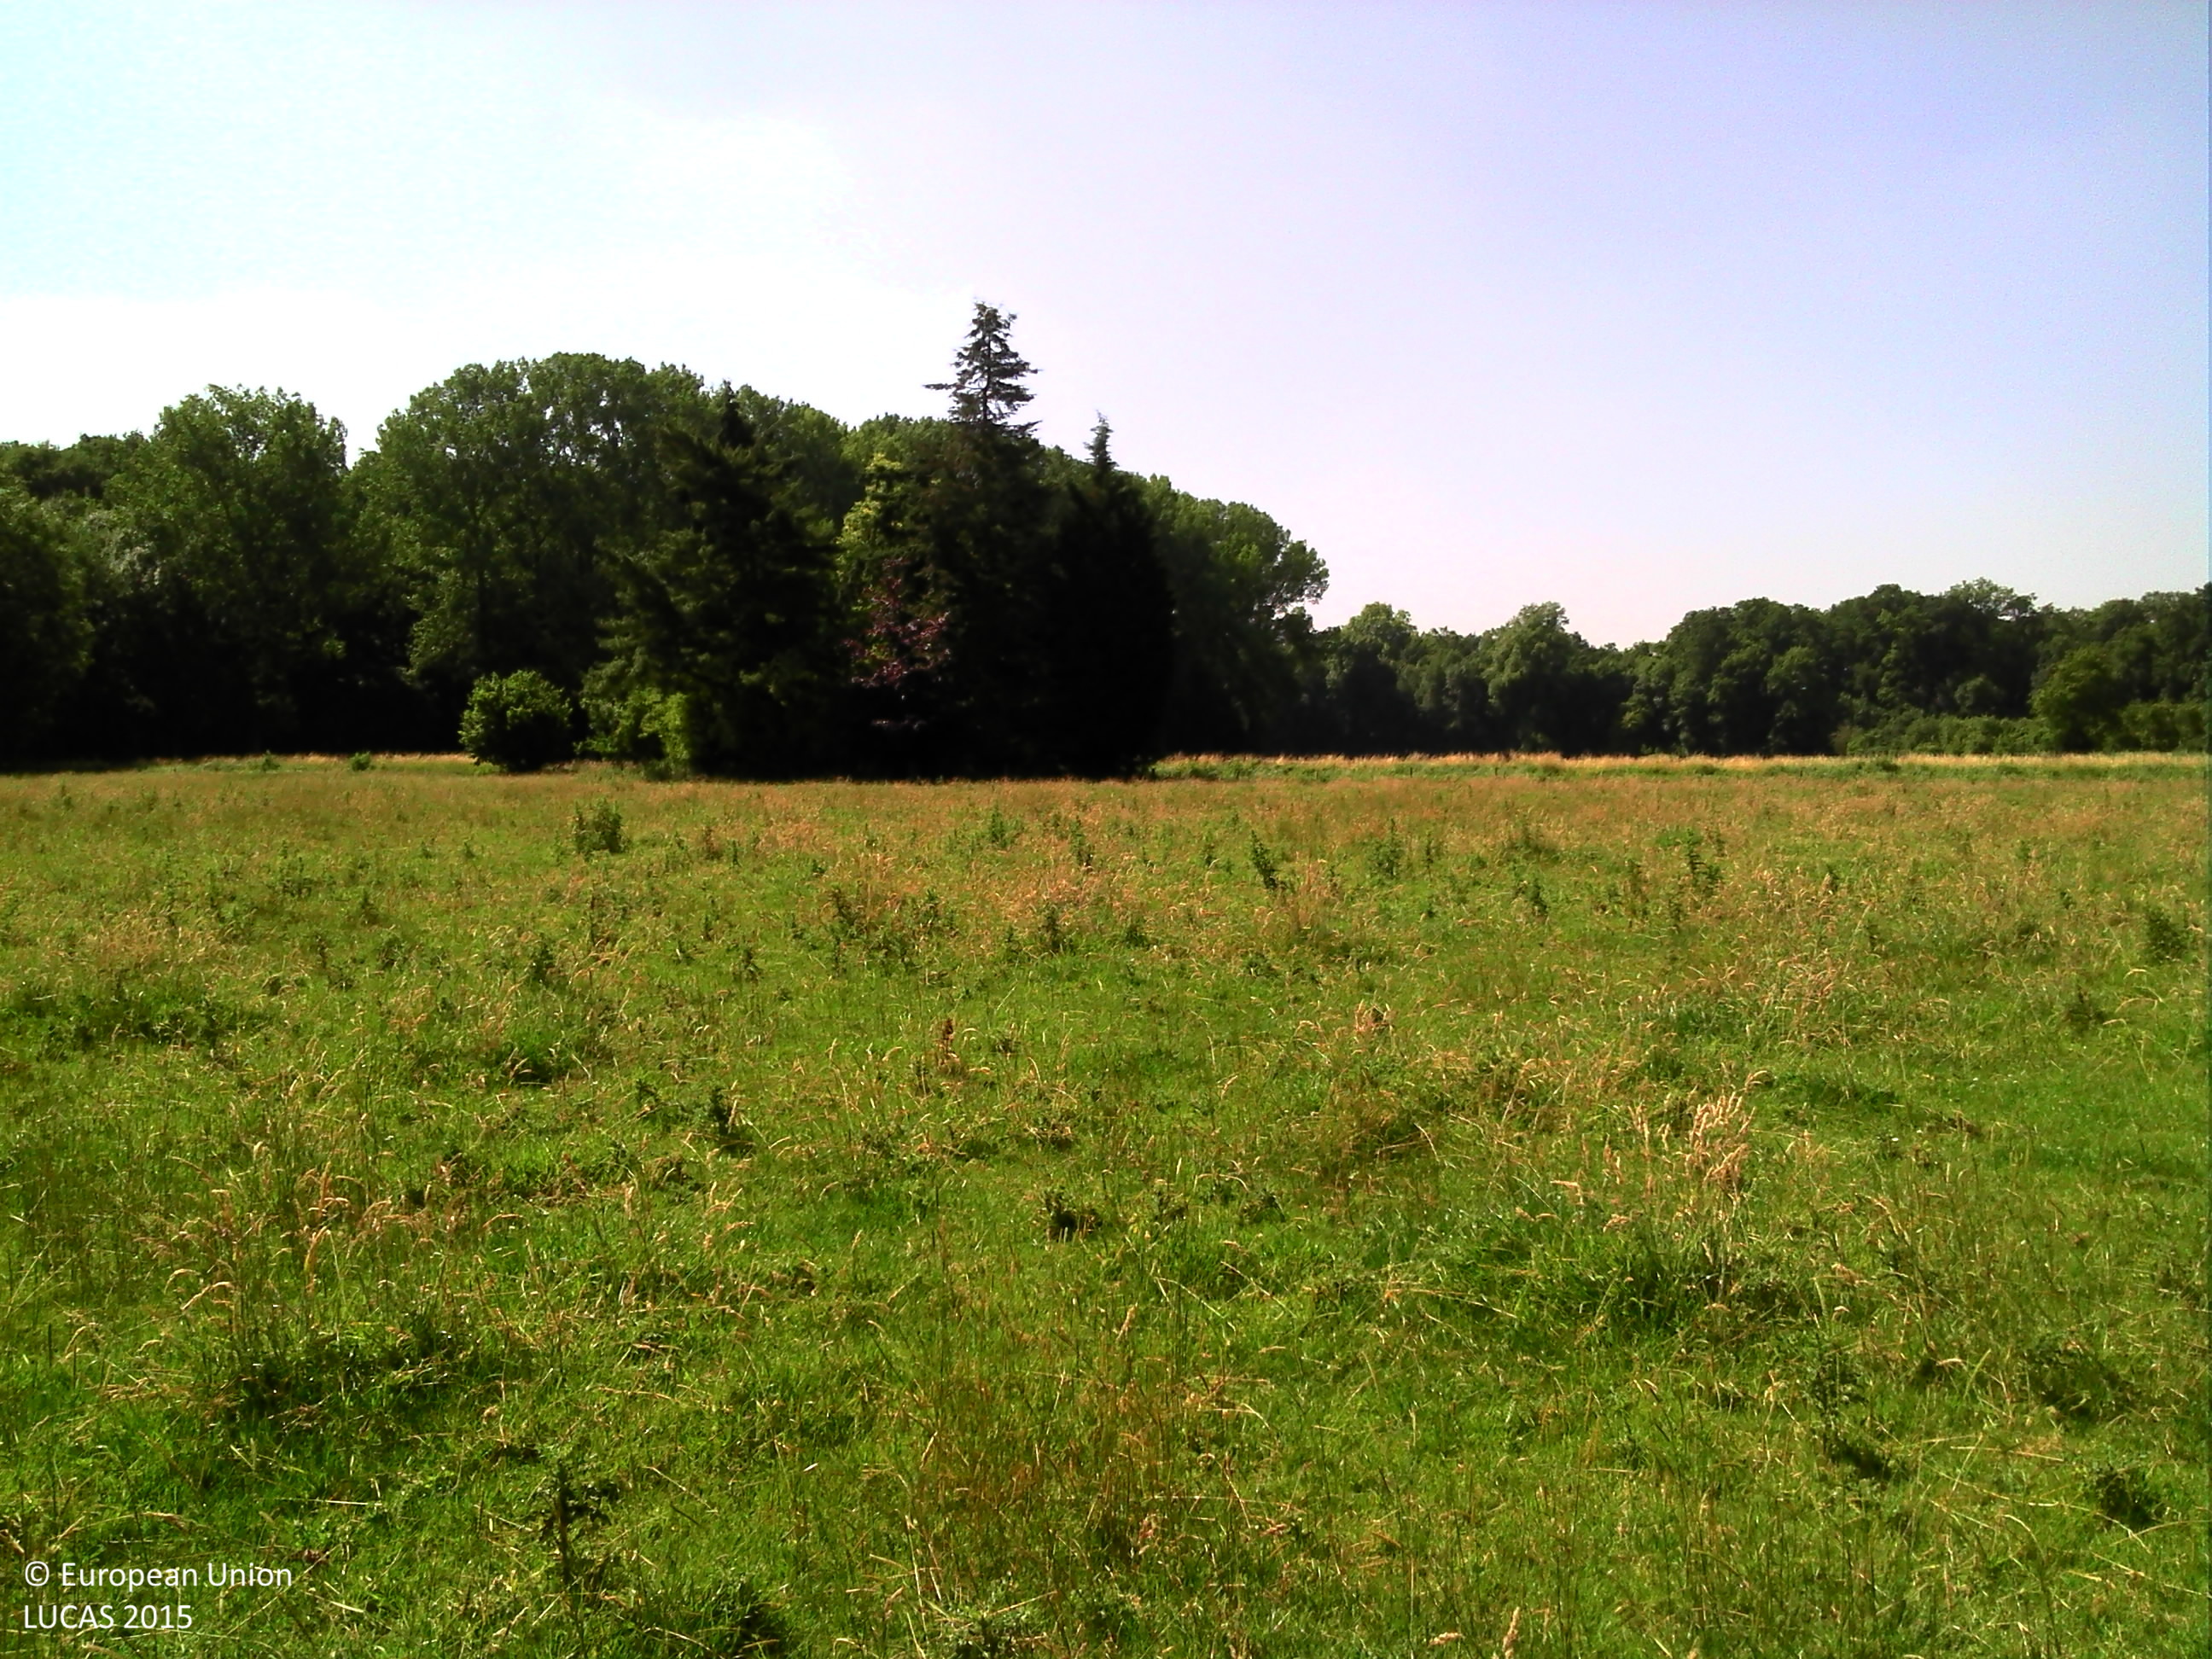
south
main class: Grassland
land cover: Grassland without tree/shrub cover
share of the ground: > 75 %
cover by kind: herbaceous plants 100 %
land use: Agriculture (excluding fallow land and kitchen gardens)
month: June
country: BE
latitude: 50.8391
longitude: 5.1835
